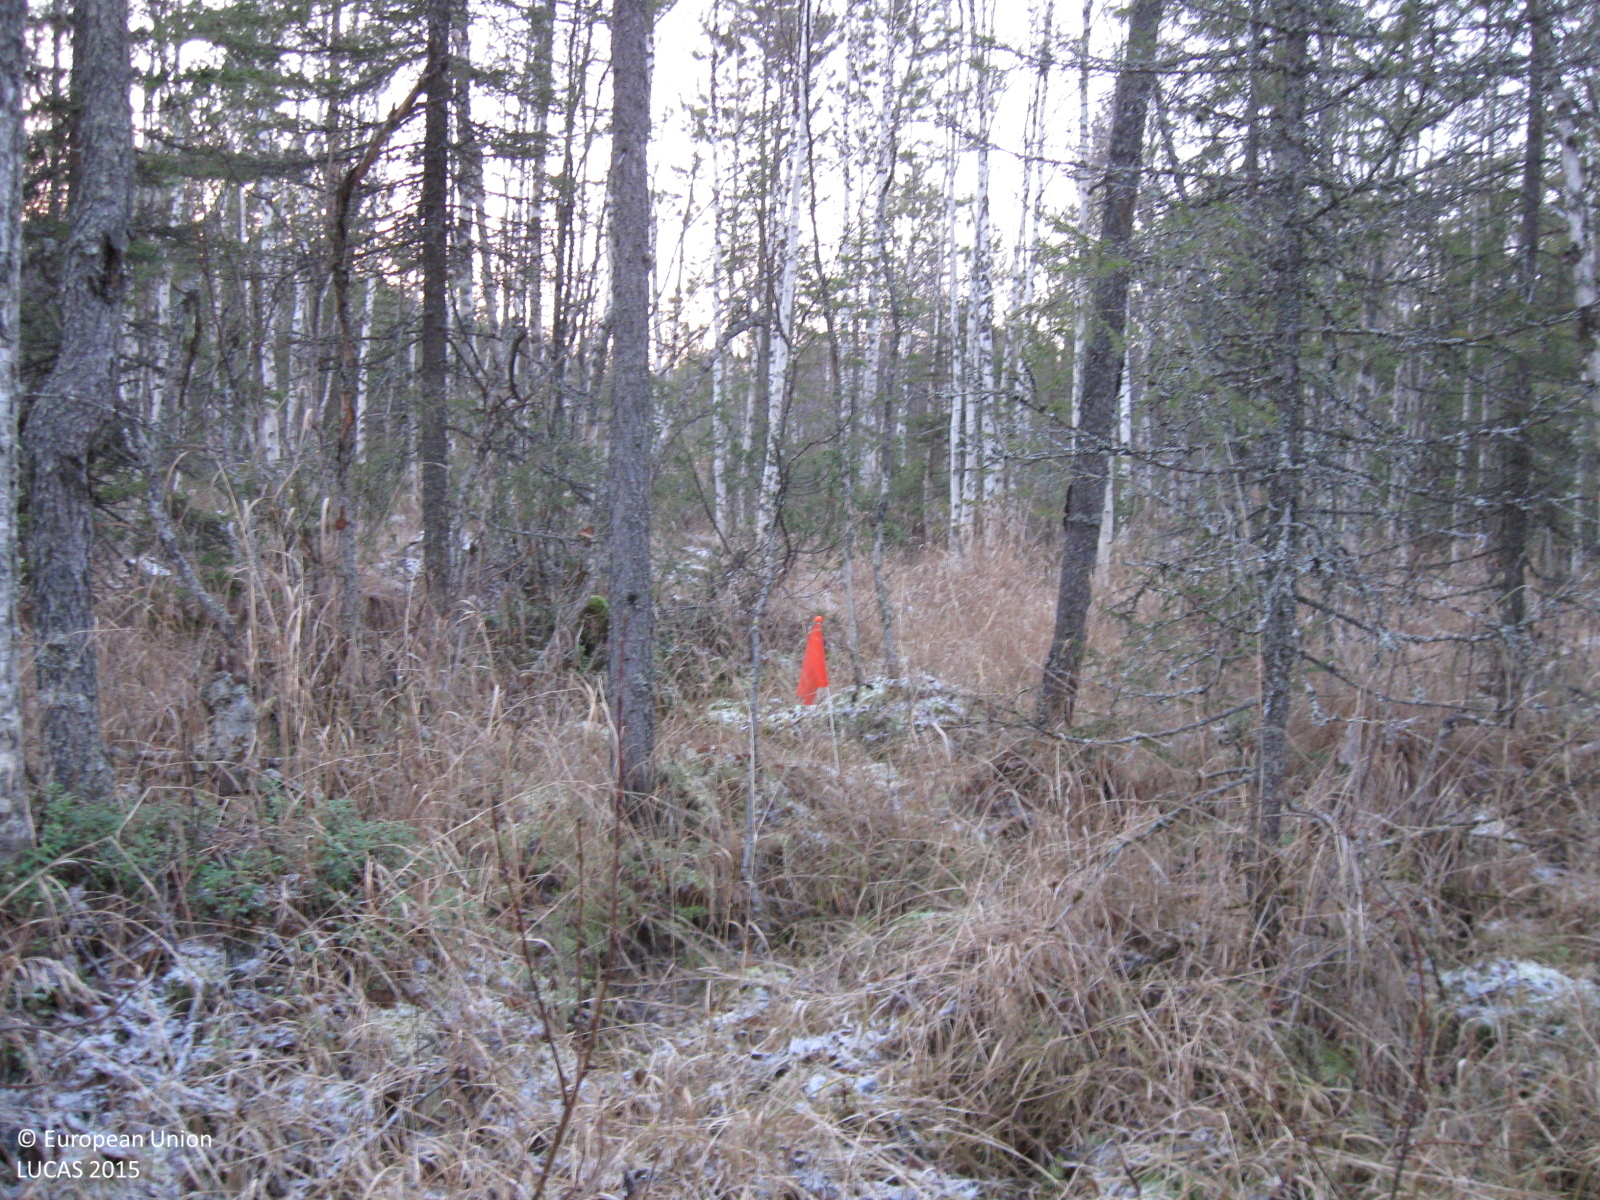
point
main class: Woodland
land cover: Spruce dominated mixed woodland
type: mire and swamp forests
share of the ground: 50 - 75 %
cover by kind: broadleaved forest trees 50 %, coniferous forest trees 20 %, herbaceous plants 20 %, shrubs 5 %, lichens and mosses 5 %
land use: Semi-natural and natural areas not in use
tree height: > 5 m
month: October
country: SE
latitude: 66.1680
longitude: 21.3433
